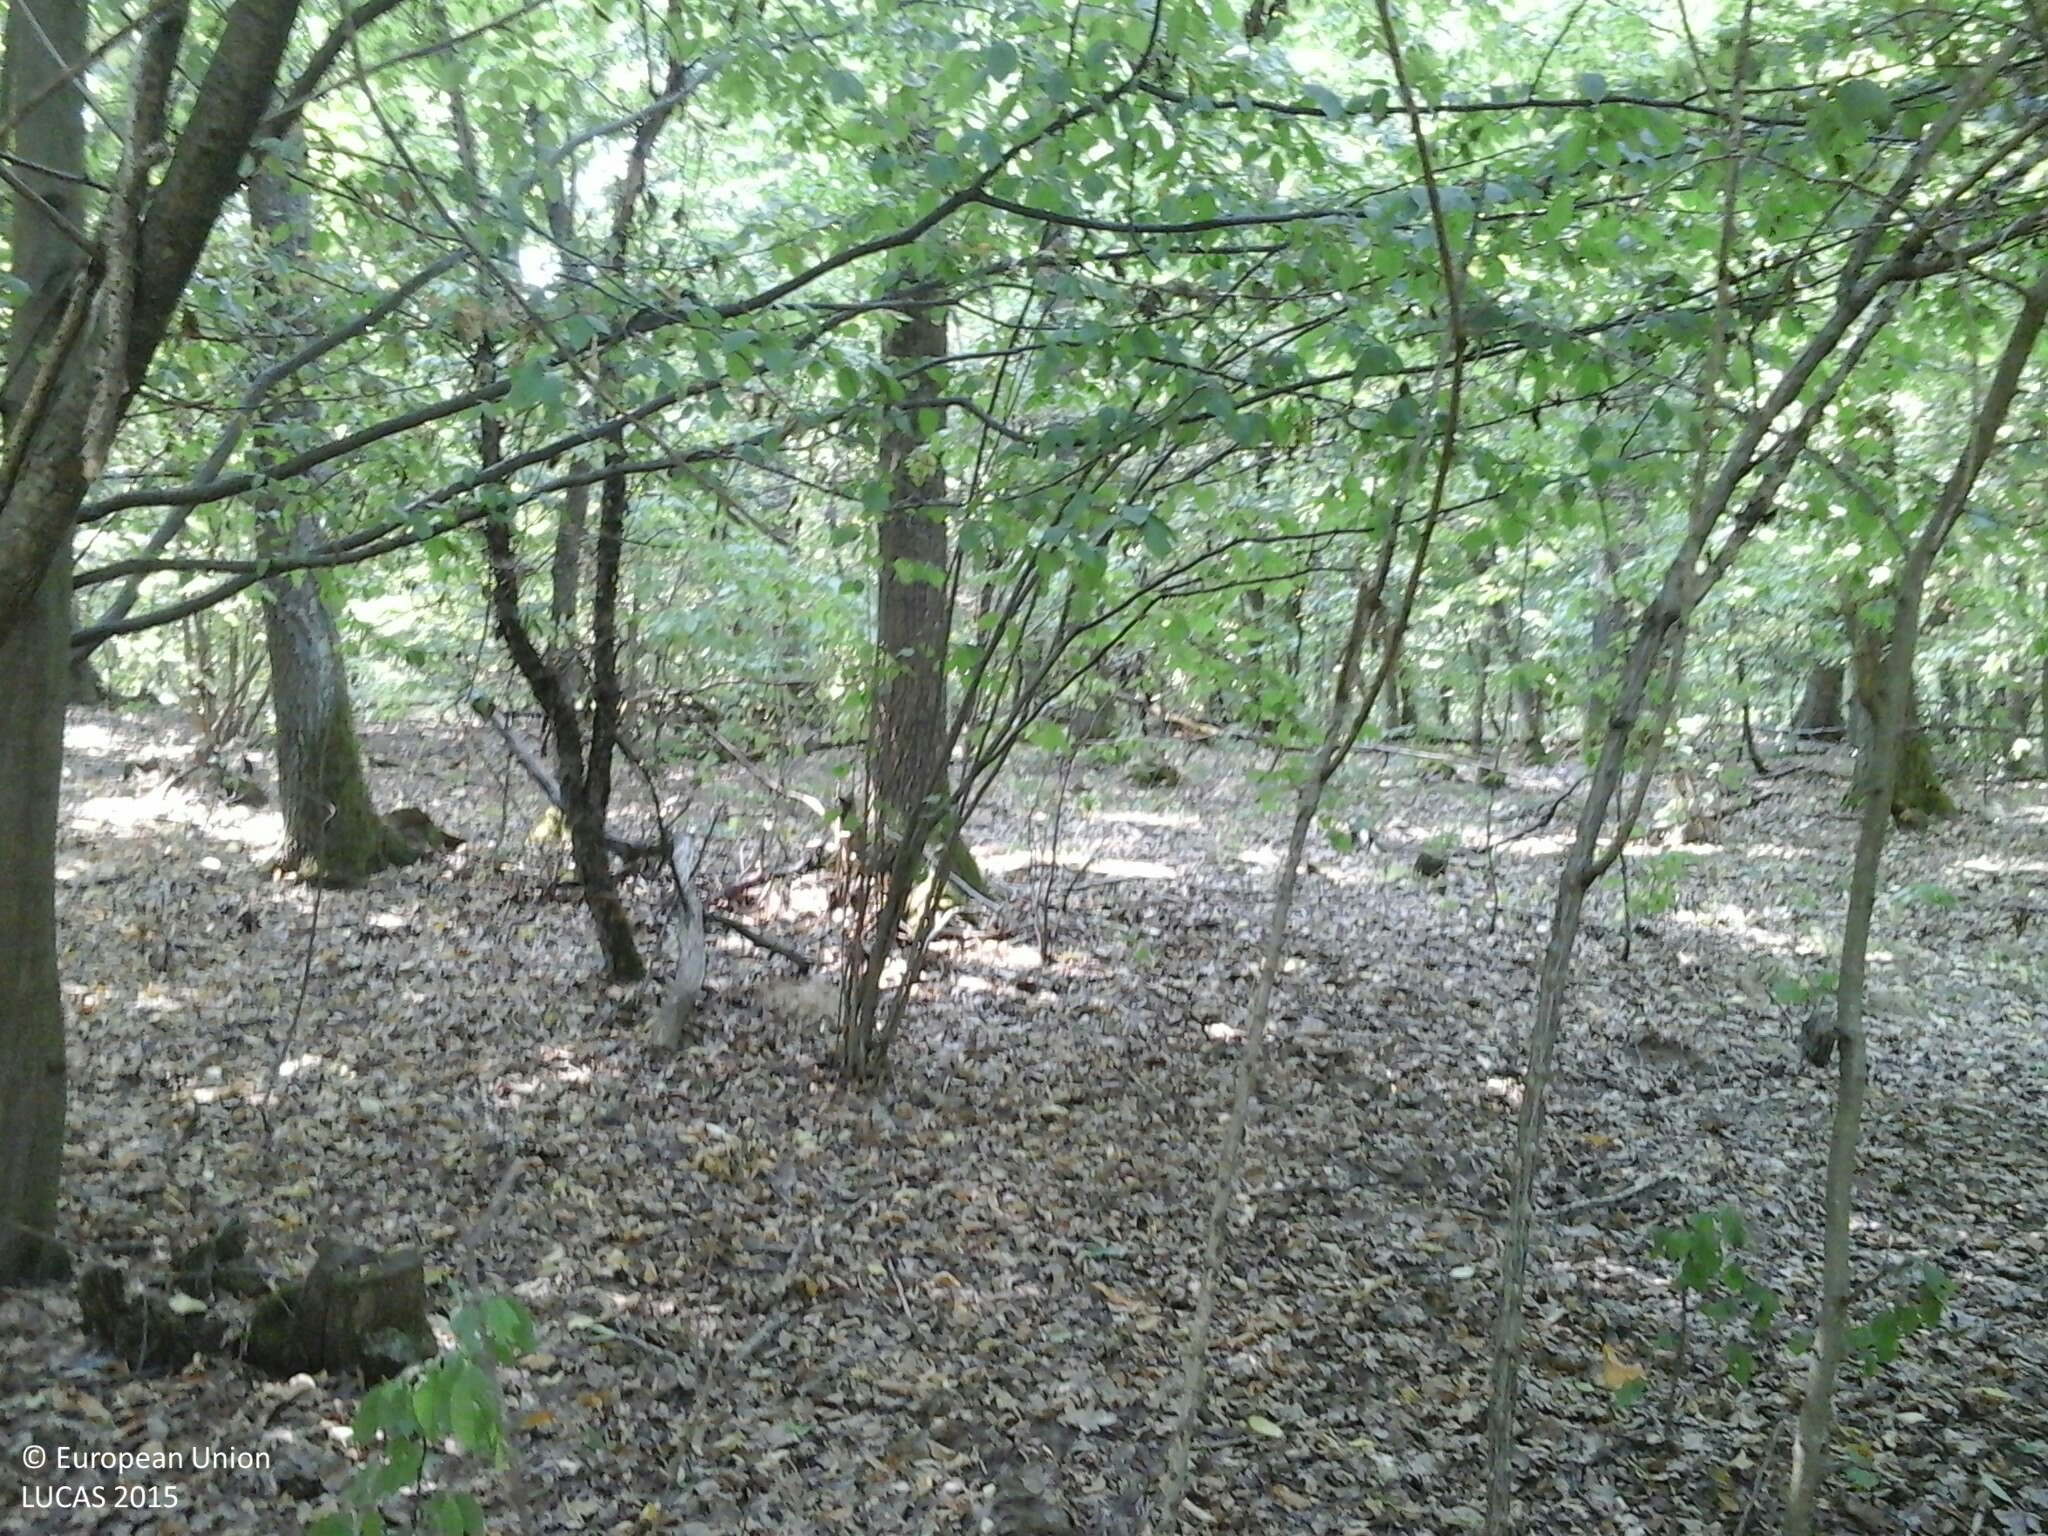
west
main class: Woodland
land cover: Broadleaved woodland
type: mesophytic deciduous forest
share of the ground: > 75 %
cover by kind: broadleaved forest trees 100 %
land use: Forestry
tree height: > 5 m
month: August
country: HU
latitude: 48.4453
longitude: 20.5121
